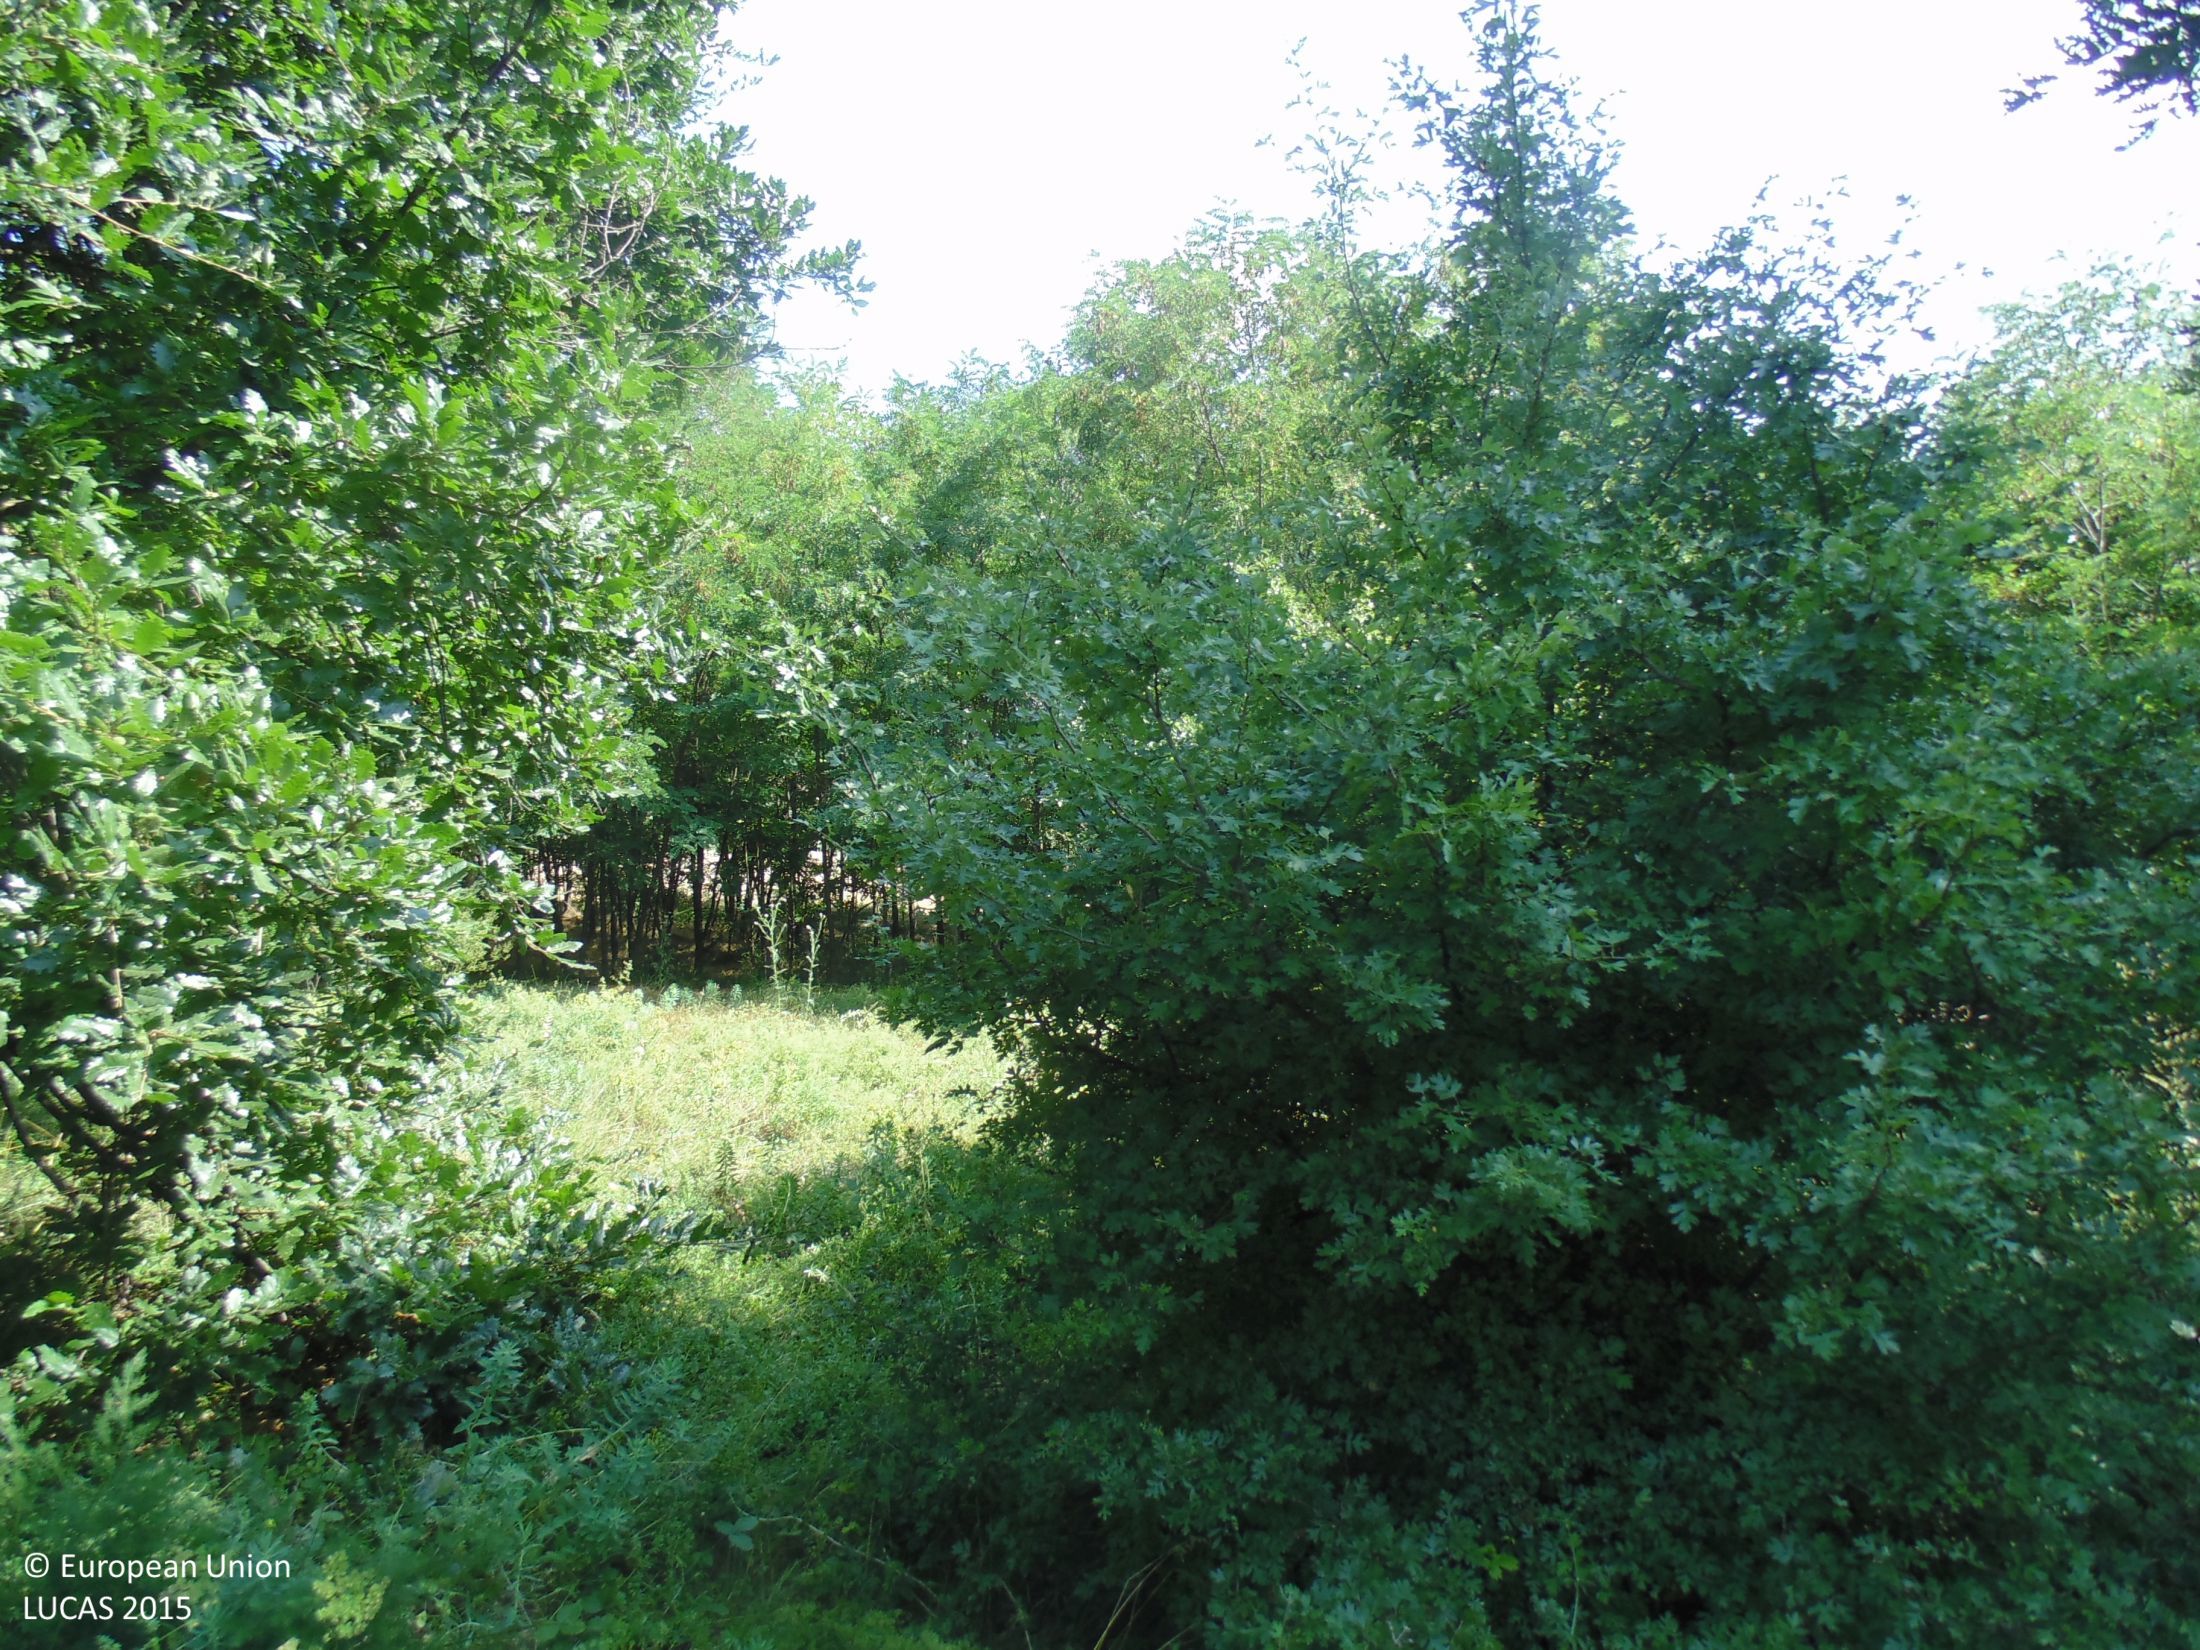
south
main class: Woodland
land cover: Broadleaved woodland
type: mesophytic deciduous forest
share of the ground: > 75 %
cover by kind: broadleaved forest trees 75 %, herbaceous plants 20 %, shrubs 5 %
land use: Forestry
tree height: > 5 m
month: July
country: BG
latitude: 43.5980
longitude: 27.5378
